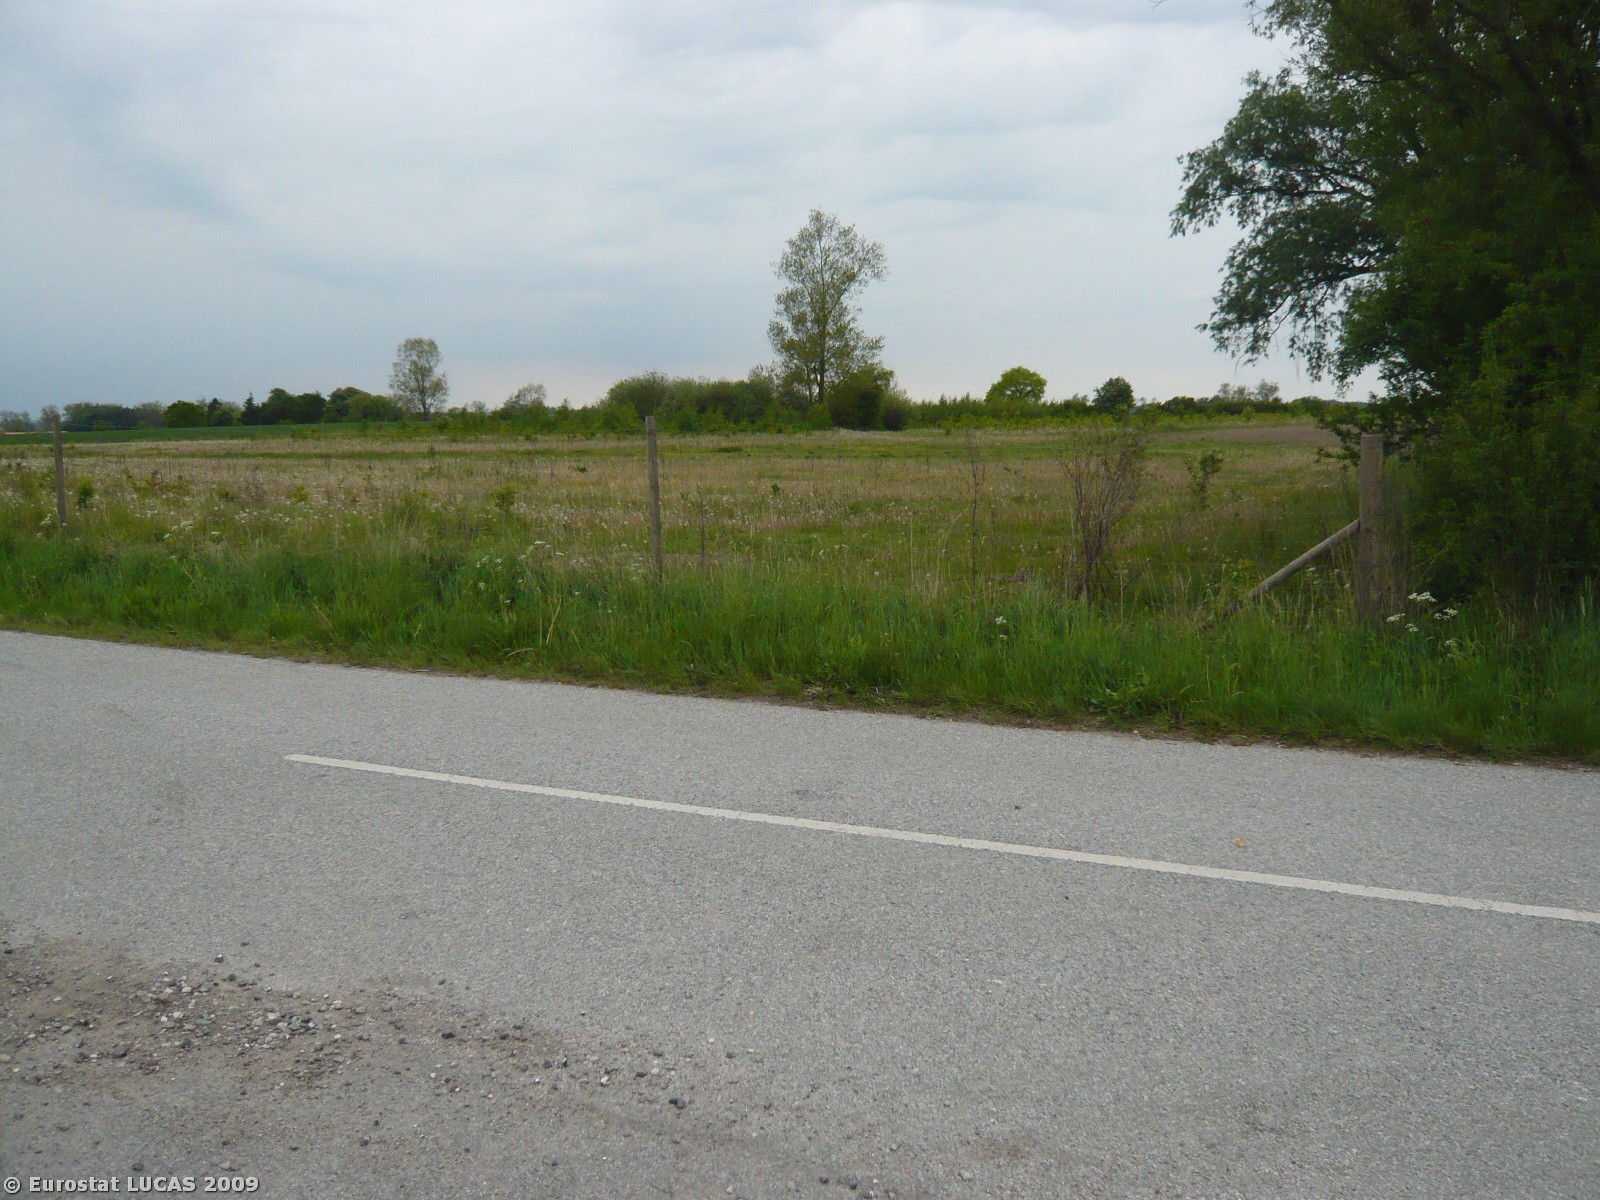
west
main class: Shrubland
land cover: Shrubland with sparse tree cover
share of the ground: 25 - 50 %
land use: Agriculture (excluding fallow land and kitchen gardens)
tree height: > 5 m
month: May
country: DK
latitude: 55.3999
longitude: 11.9407
